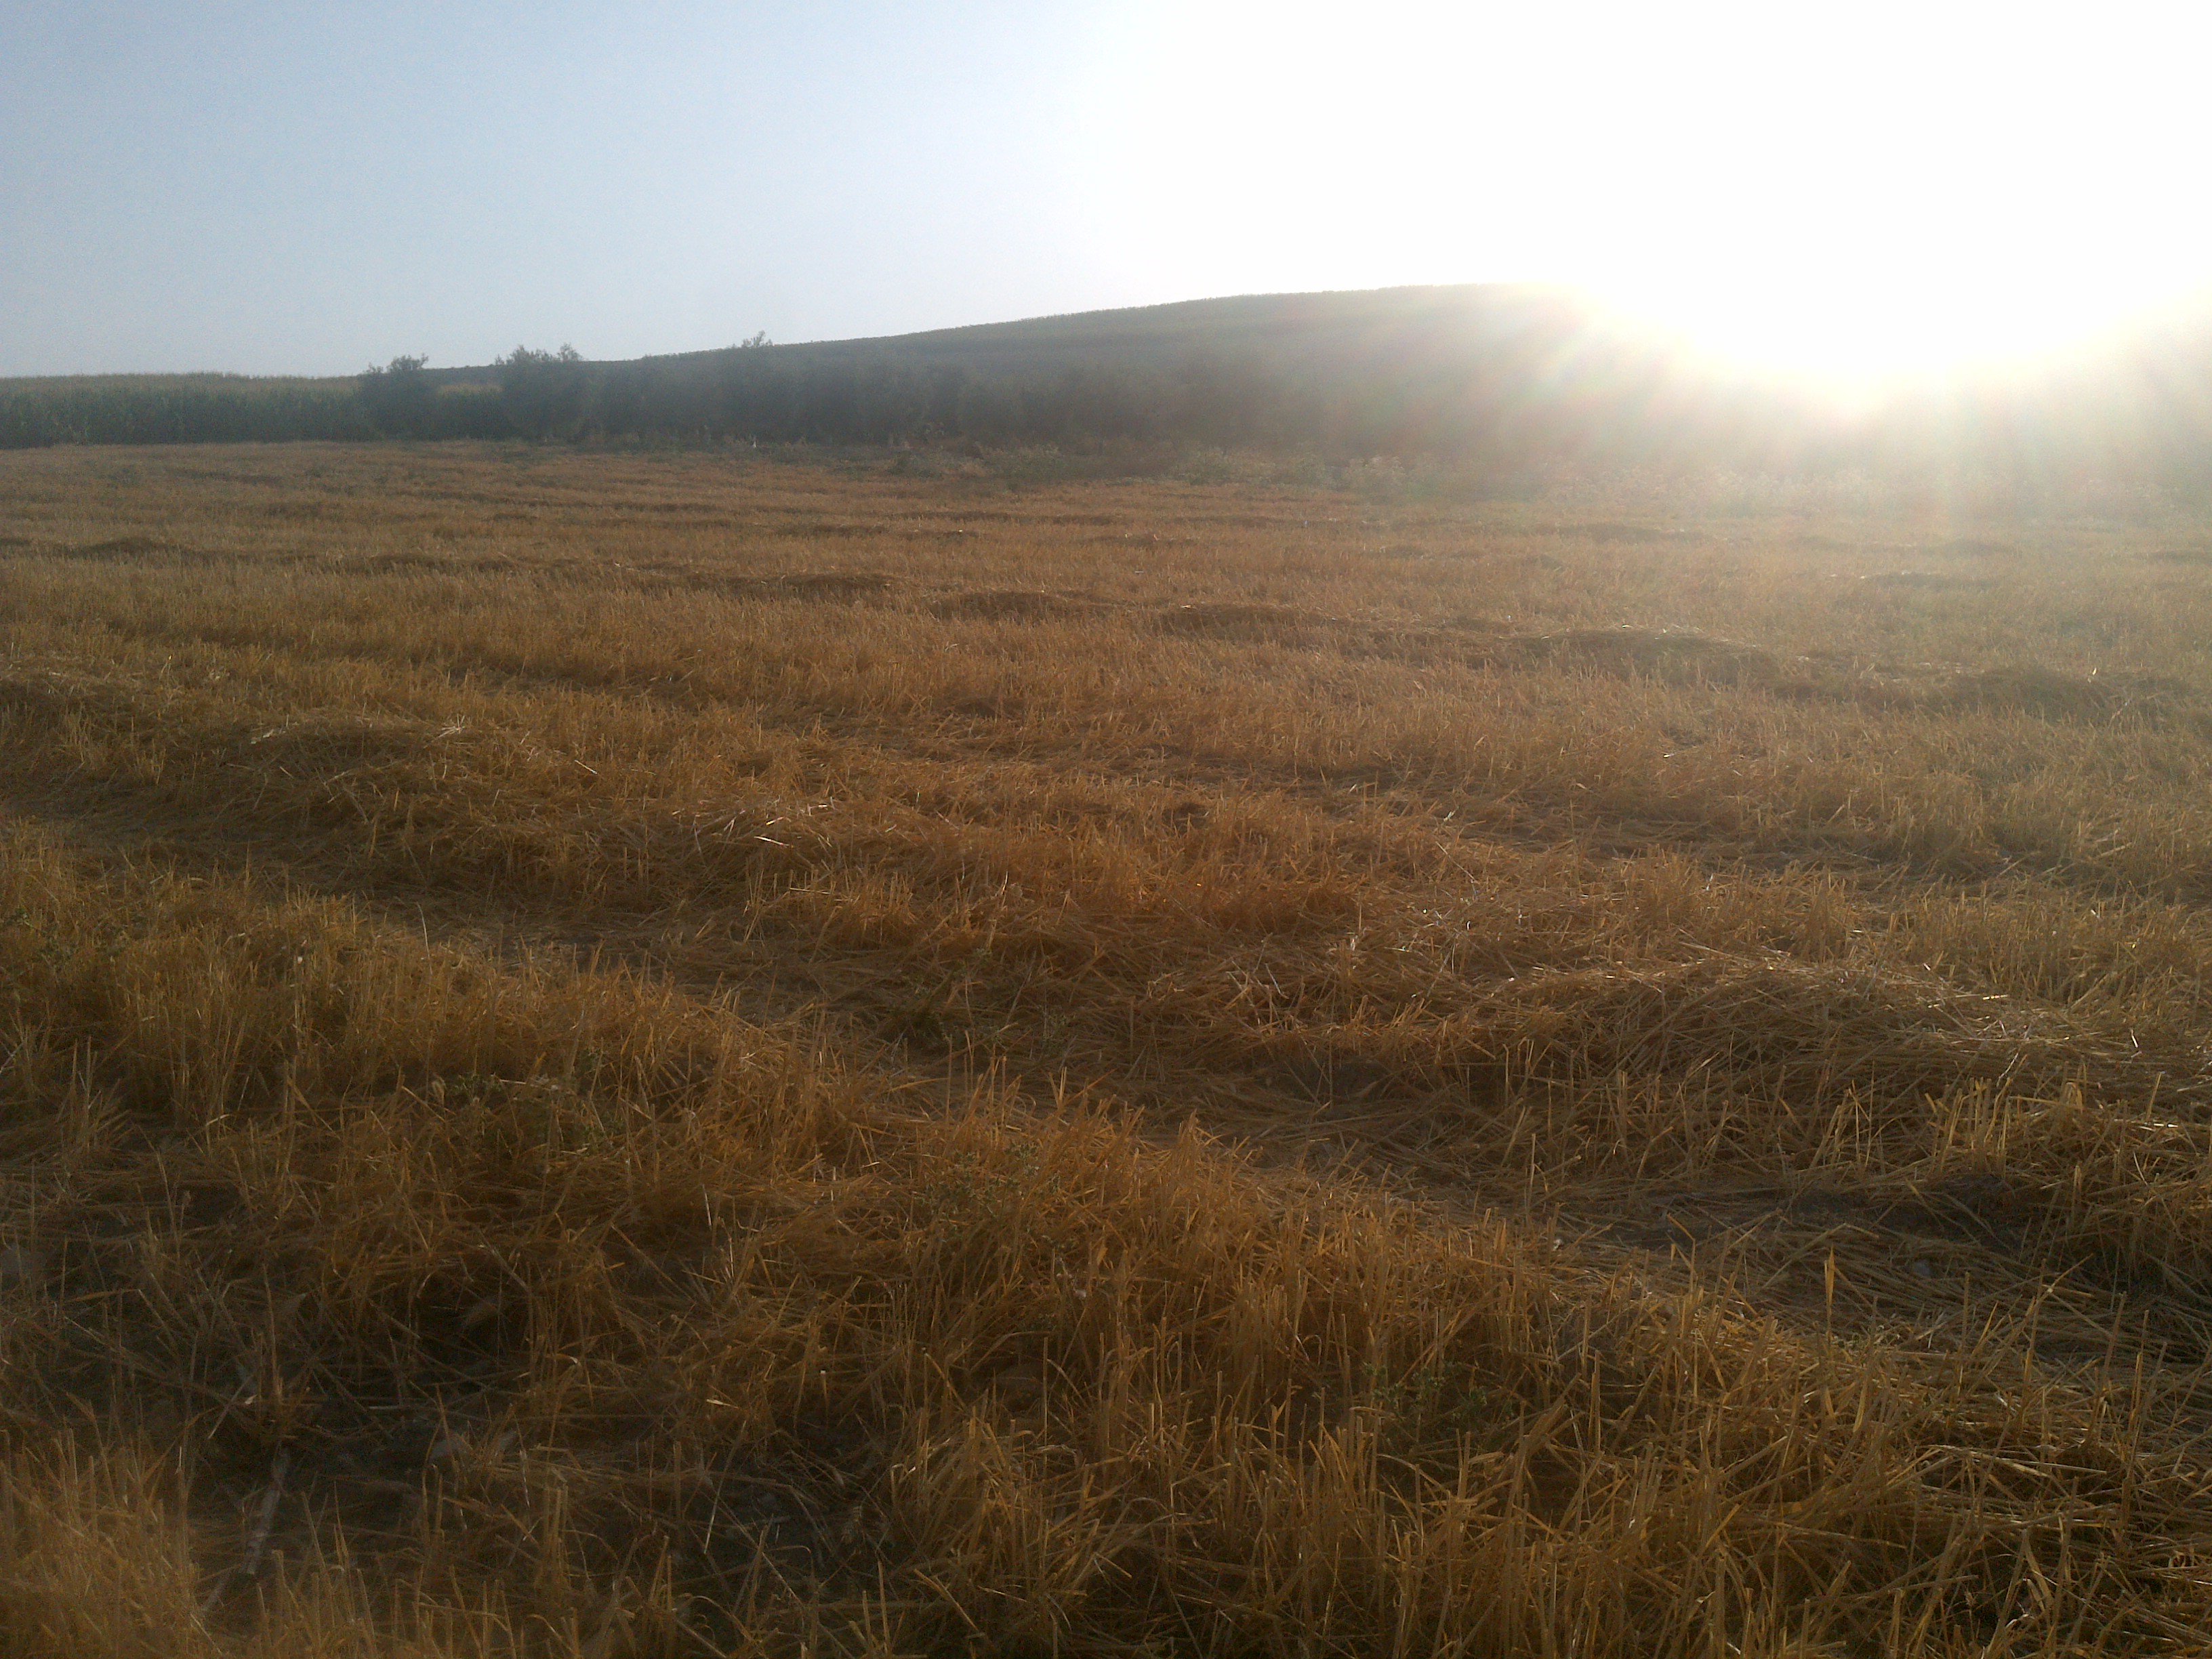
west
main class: Cropland
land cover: Durum wheat
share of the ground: < 10 %
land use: Agriculture (excluding fallow land and kitchen gardens)
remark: Harvested field
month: July
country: ES
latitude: 37.4787
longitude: -4.8334
